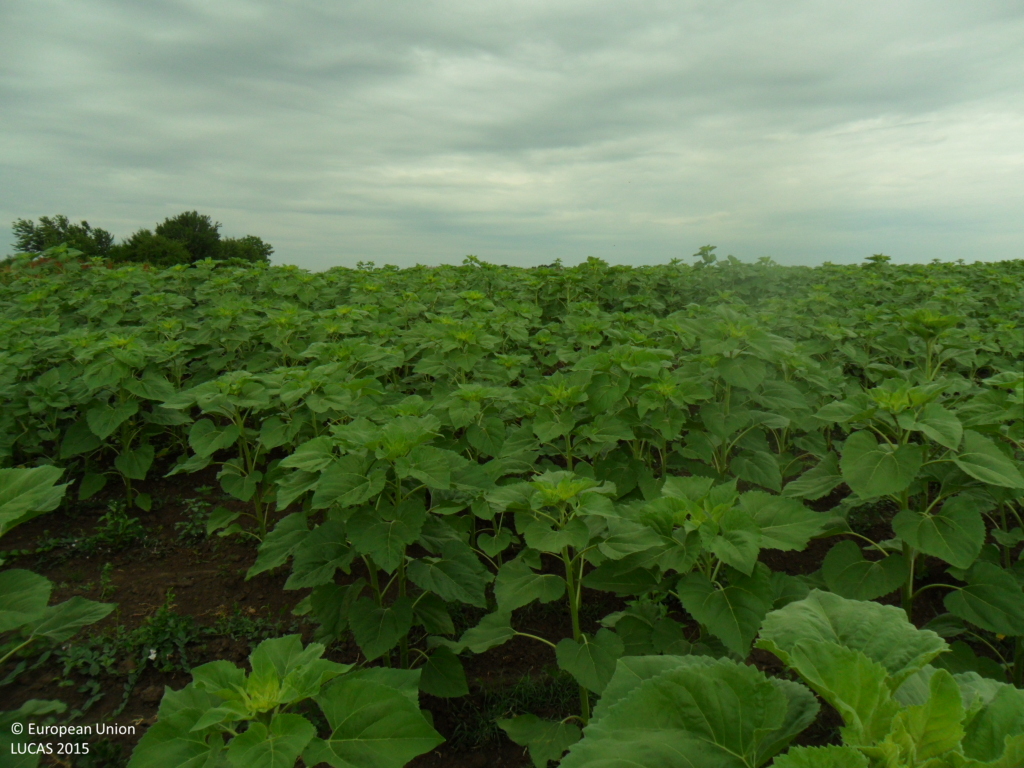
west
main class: Cropland
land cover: Sunflower
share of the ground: > 75 %
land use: Agriculture (excluding fallow land and kitchen gardens)
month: June
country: BG
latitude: 43.7362
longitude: 26.9424
